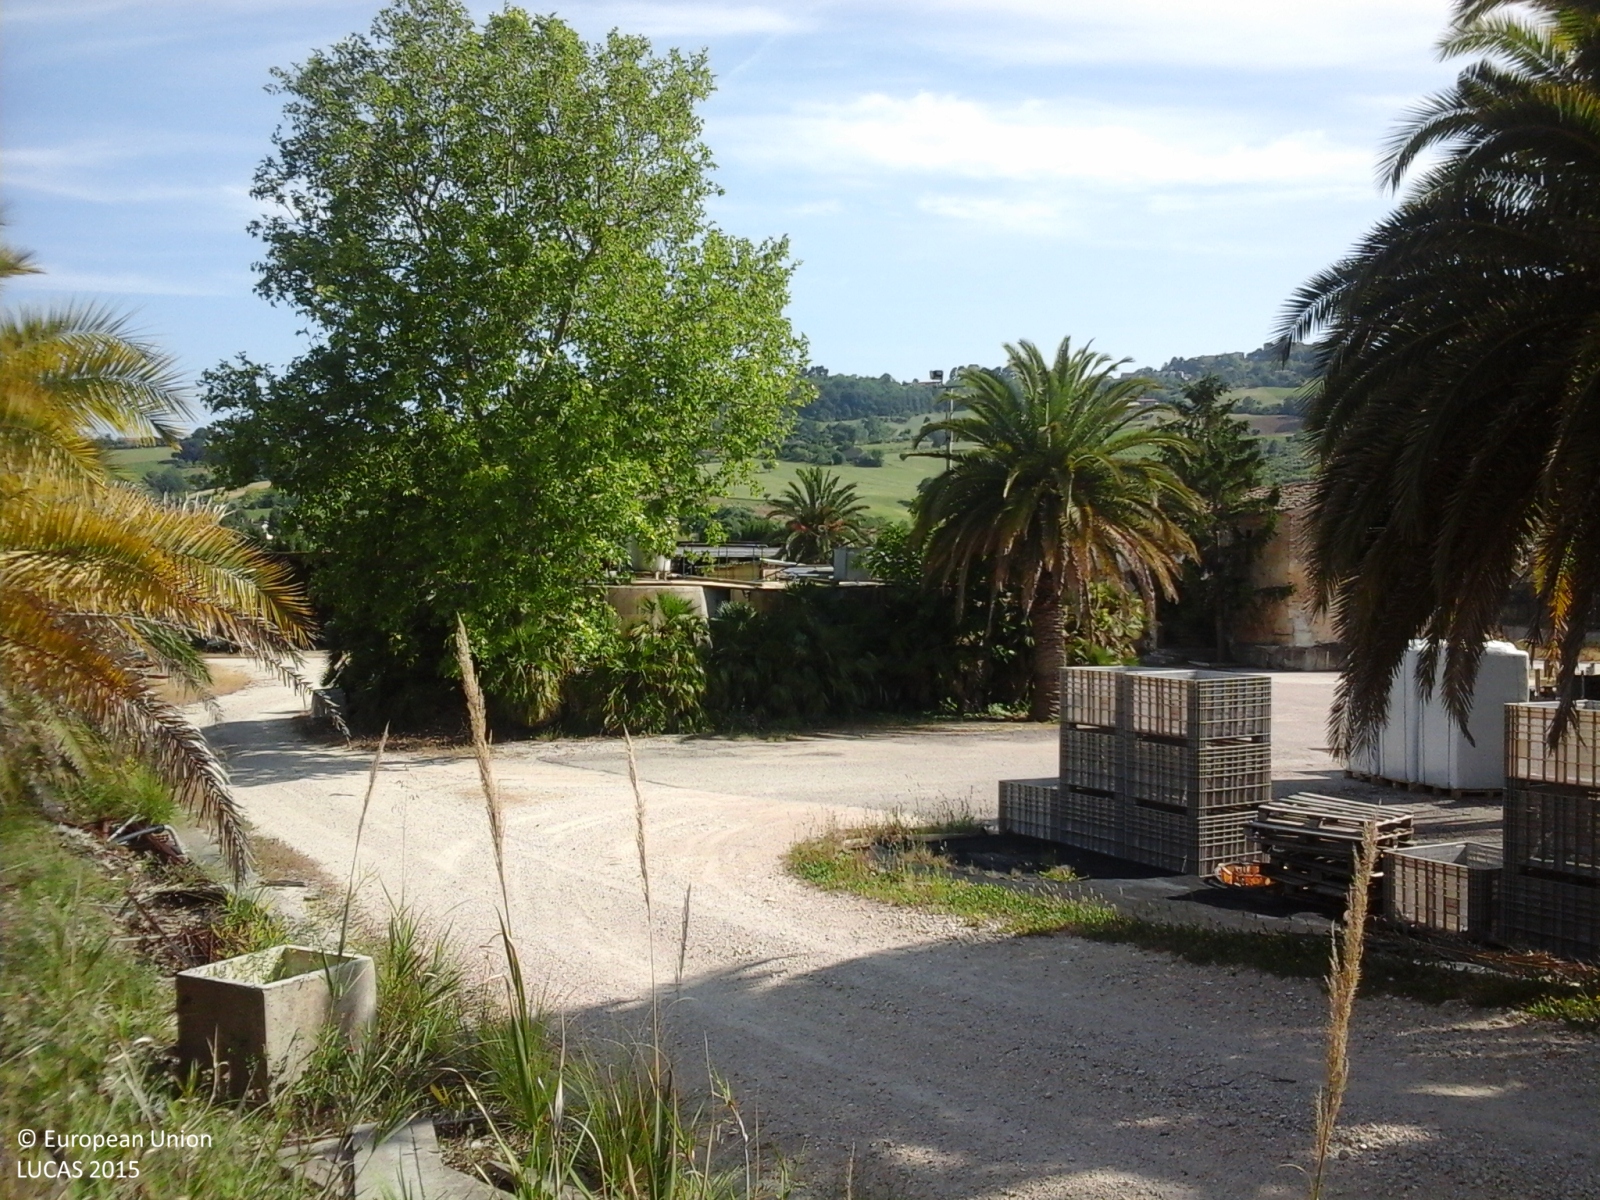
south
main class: Grassland
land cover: Grassland without tree/shrub cover
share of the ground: > 75 %
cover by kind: herbaceous plants 100 %
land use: Abandoned areas
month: May
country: IT
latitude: 42.9613
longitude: 13.8268
